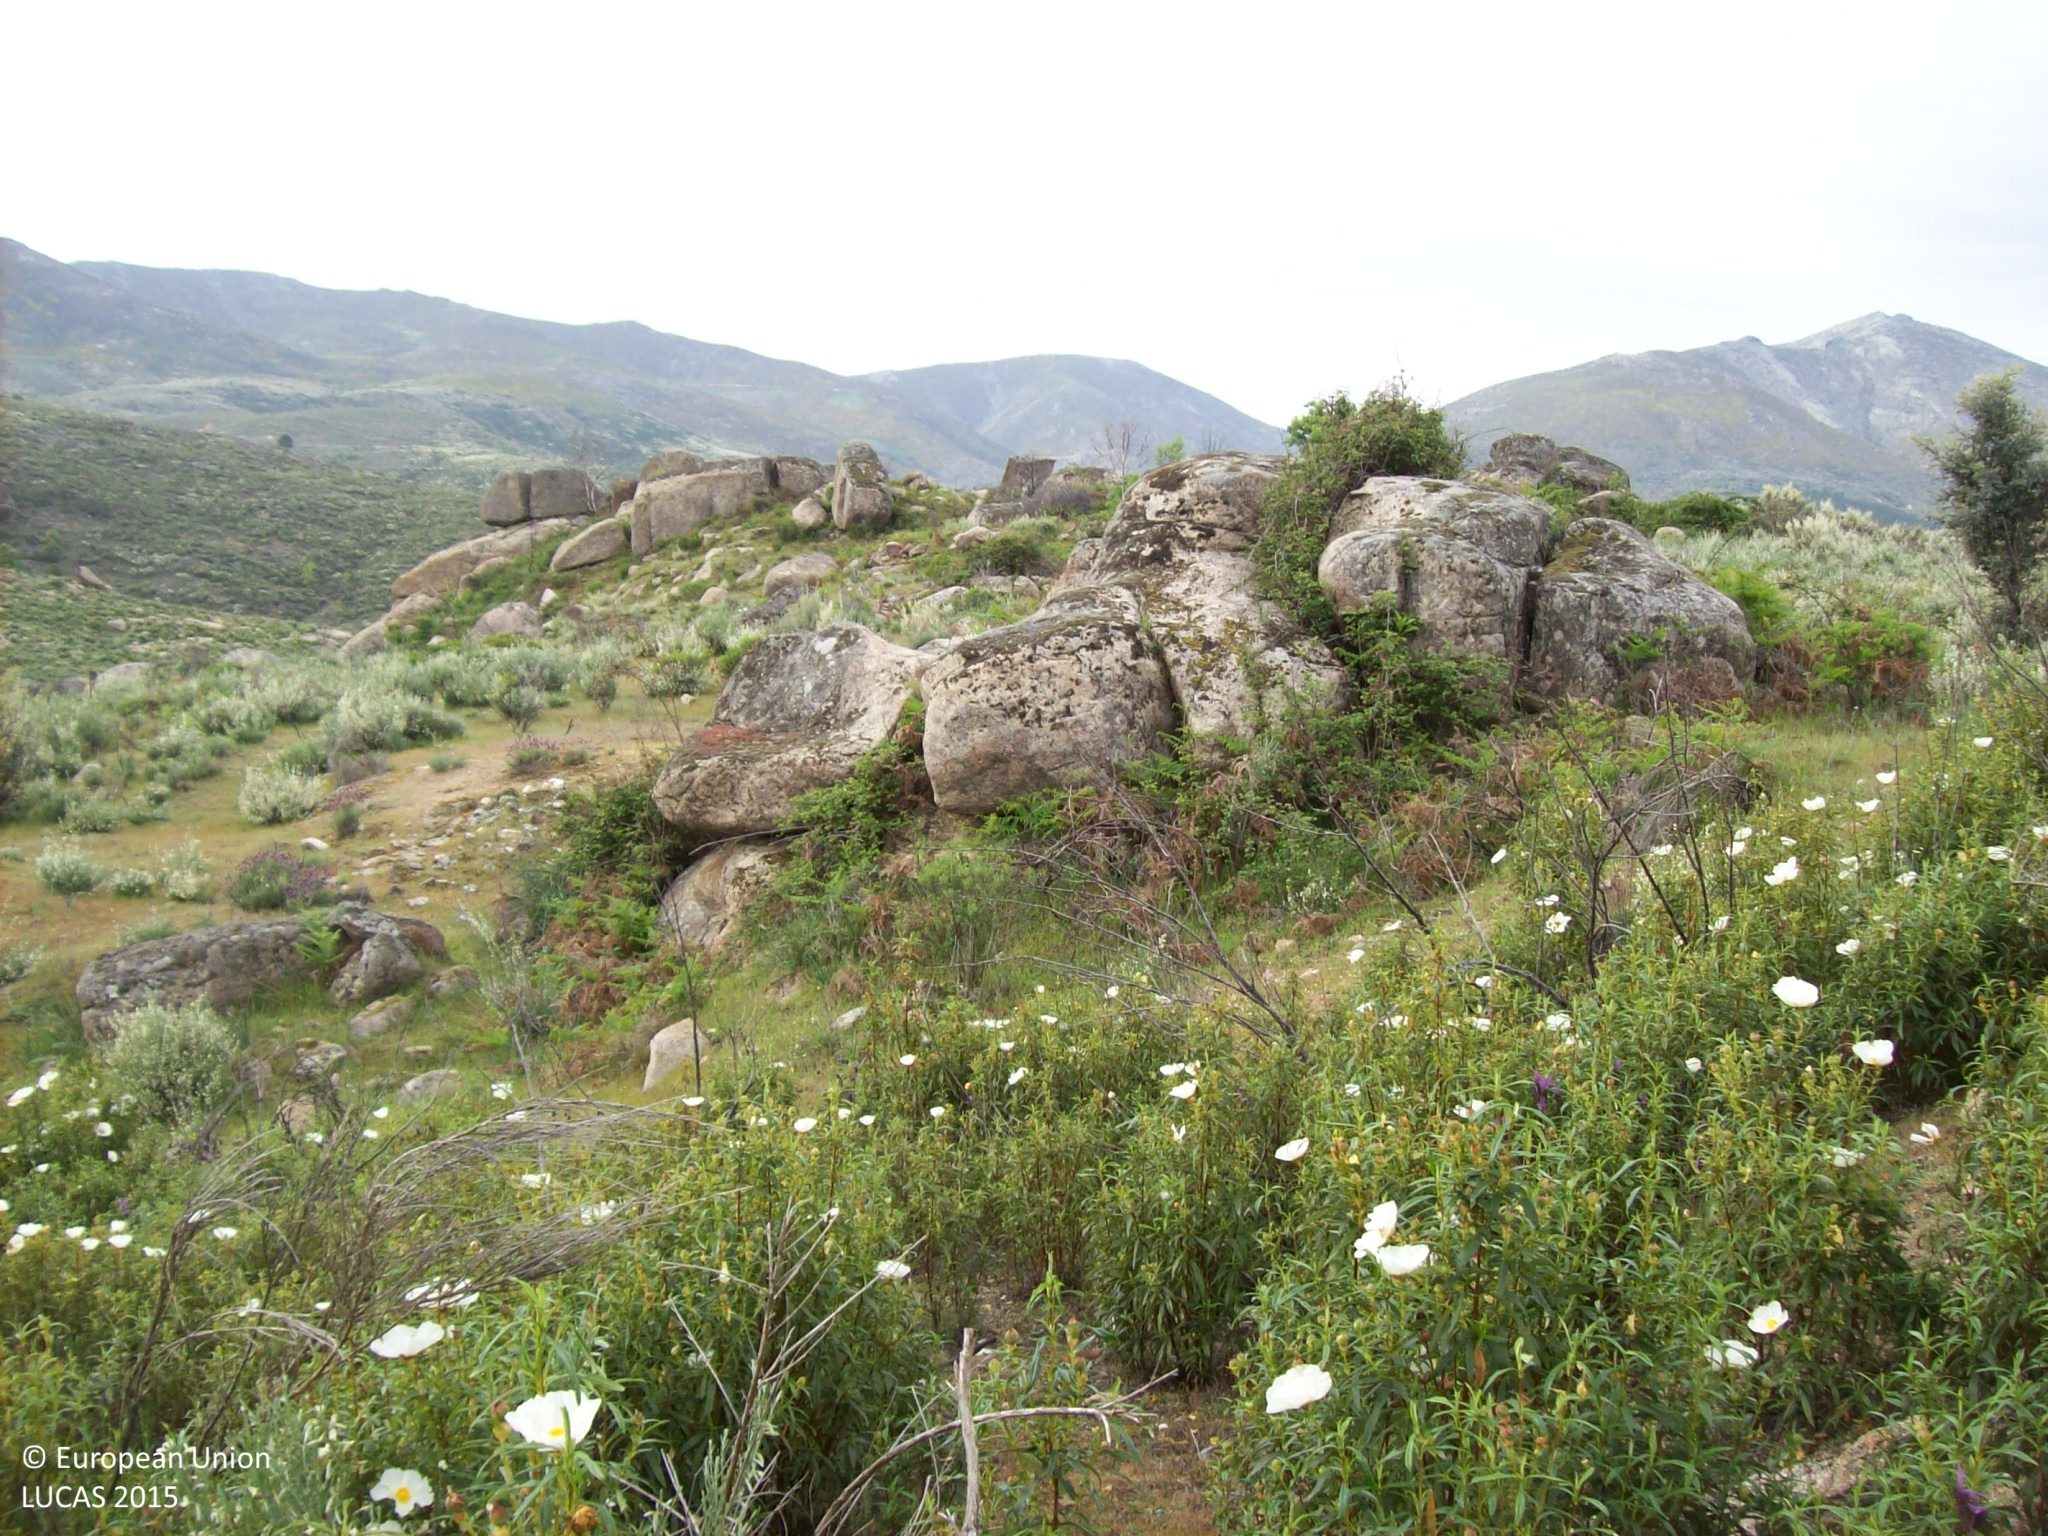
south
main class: Shrubland
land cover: Shrubland without tree cover
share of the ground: 25 - 50 %
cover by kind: herbaceous plants 45 %, shrubs 40 %, consolidated bare surface 10 %
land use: Agriculture (excluding fallow land and kitchen gardens)
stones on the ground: < 10 %
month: May
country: ES
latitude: 40.3876
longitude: -4.7902
